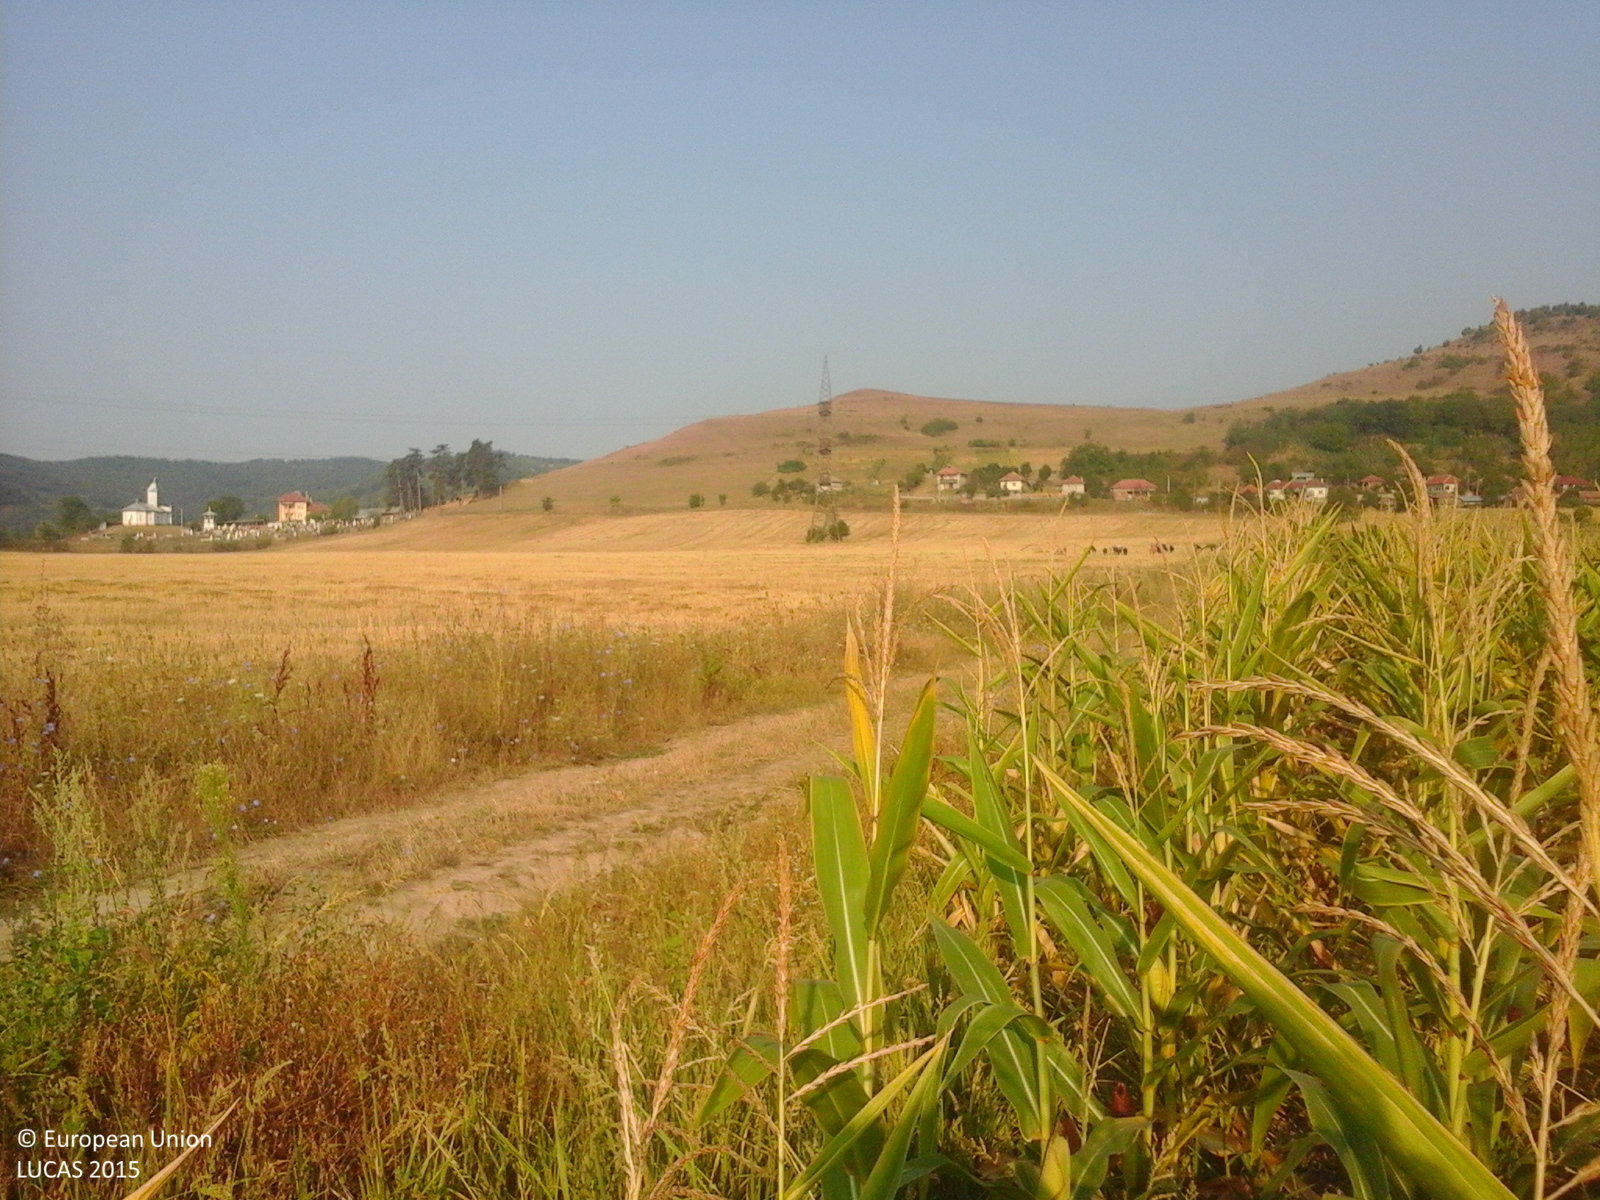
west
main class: Cropland
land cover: Maize
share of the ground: > 75 %
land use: Agriculture (excluding fallow land and kitchen gardens)
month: August
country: RO
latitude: 44.7624
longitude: 23.4849
